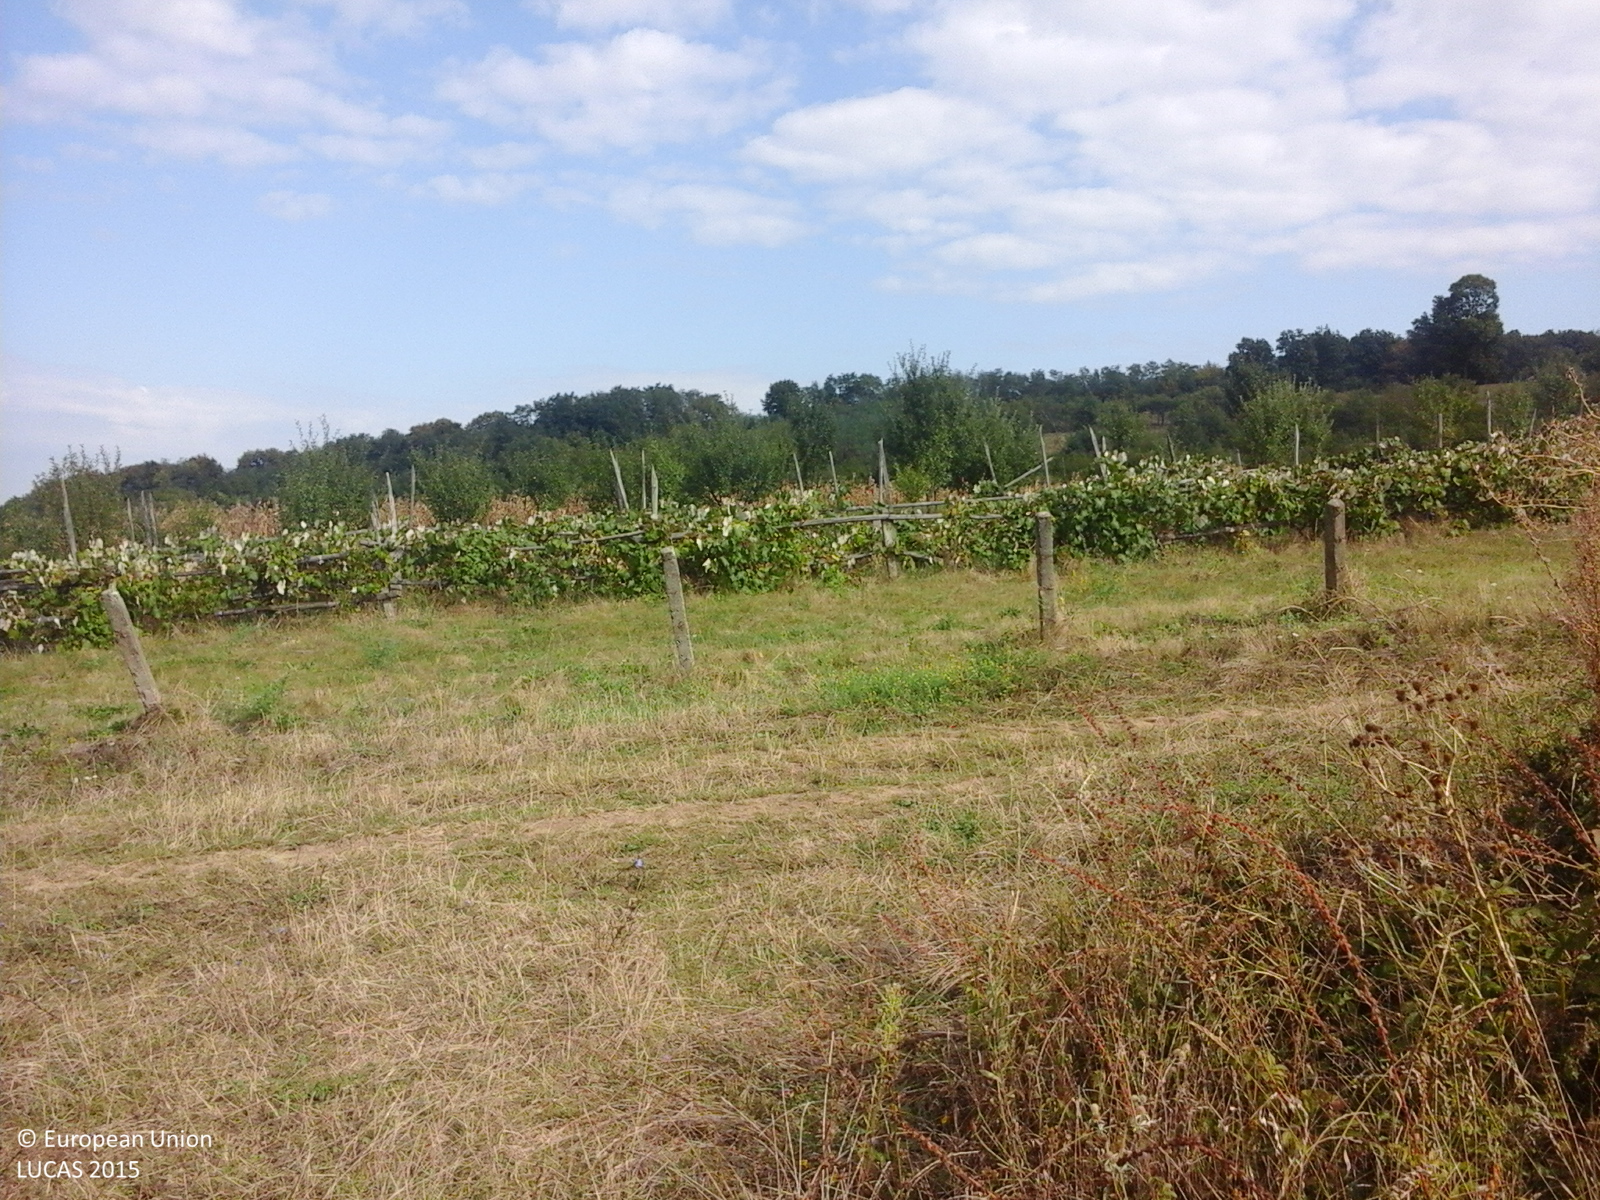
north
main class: Grassland
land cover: Spontaneously vegetated surfaces
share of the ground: > 75 %
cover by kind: herbaceous plants 100 %
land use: Fallow land
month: September
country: RO
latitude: 47.4571
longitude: 23.2405
